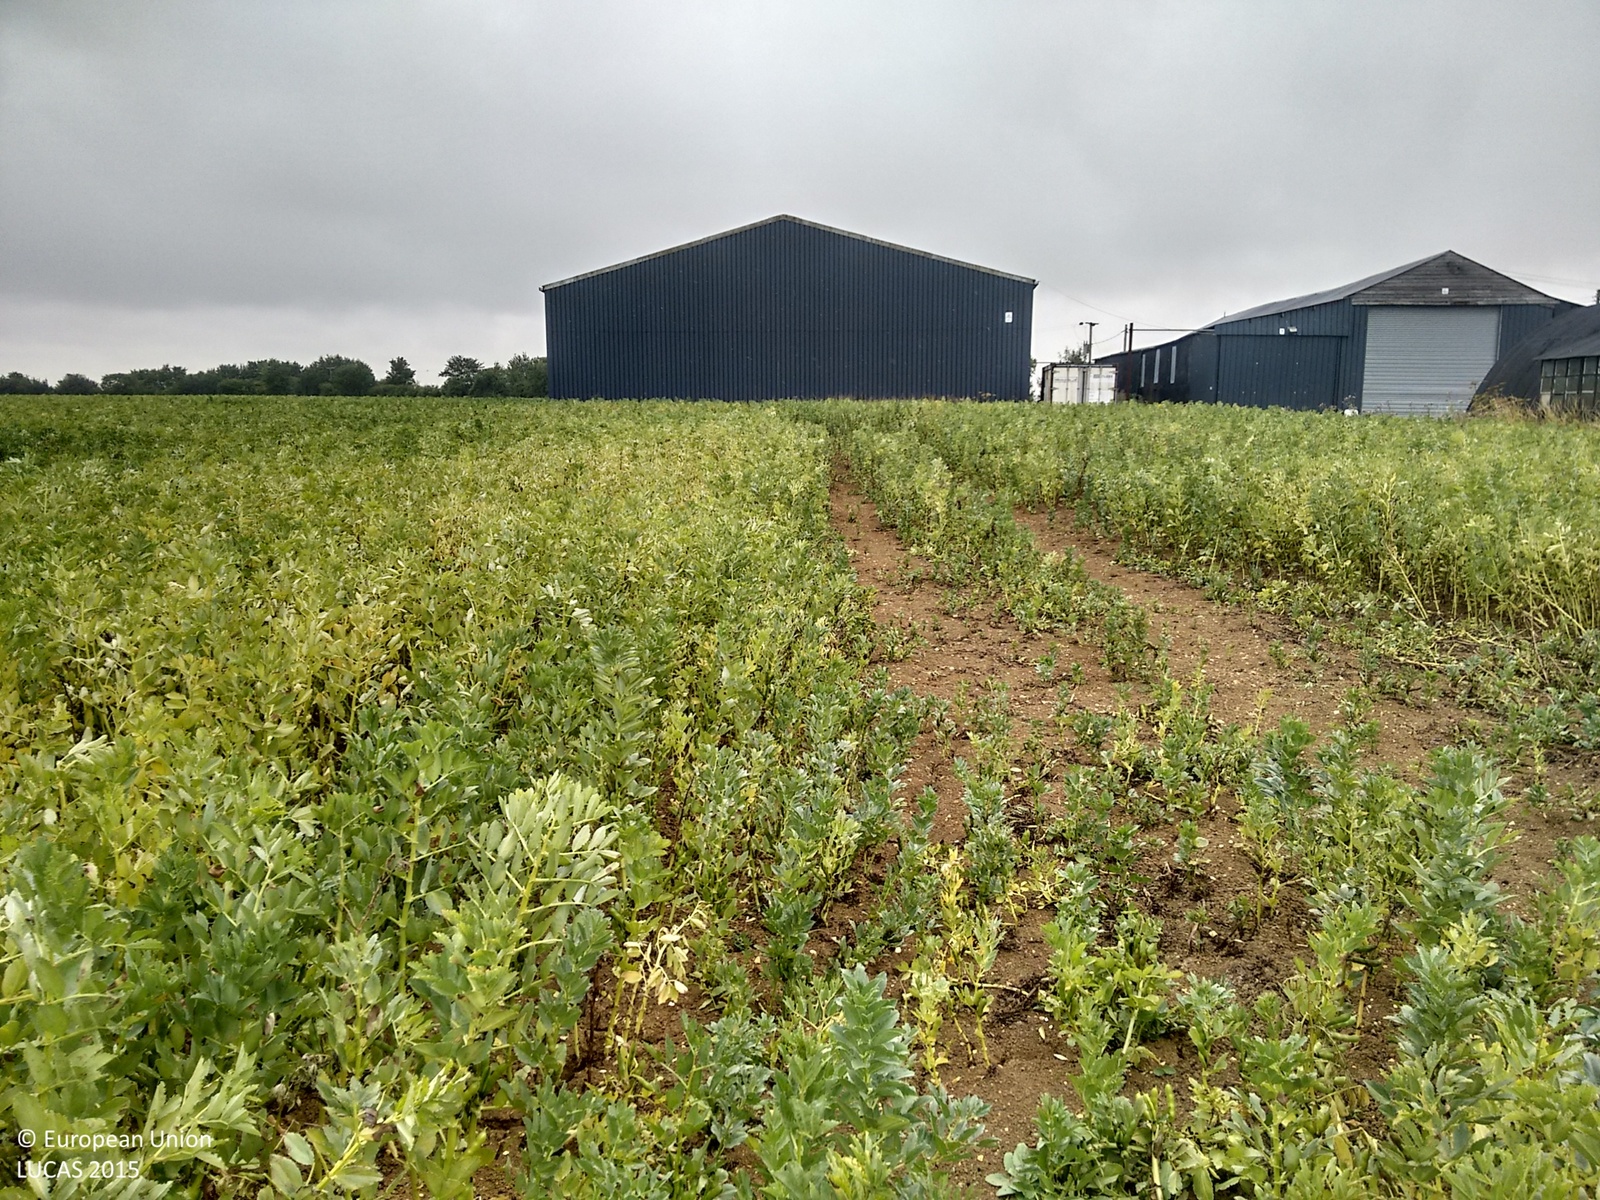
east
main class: Cropland
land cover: Dry pulses
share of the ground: > 75 %
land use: Agriculture (excluding fallow land and kitchen gardens)
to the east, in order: Dry pulses; Grass margins; Artificial constructions in urban areas; Grass margins; Dry pulses; Grass margins; Ditches and canals; Managed hedges; Grass margins; Paved roads, cycling and walking lanes; Grass margins; Managed hedges; Grass margins; Dry pulses
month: July
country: GB
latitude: 51.7827
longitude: 0.3310
